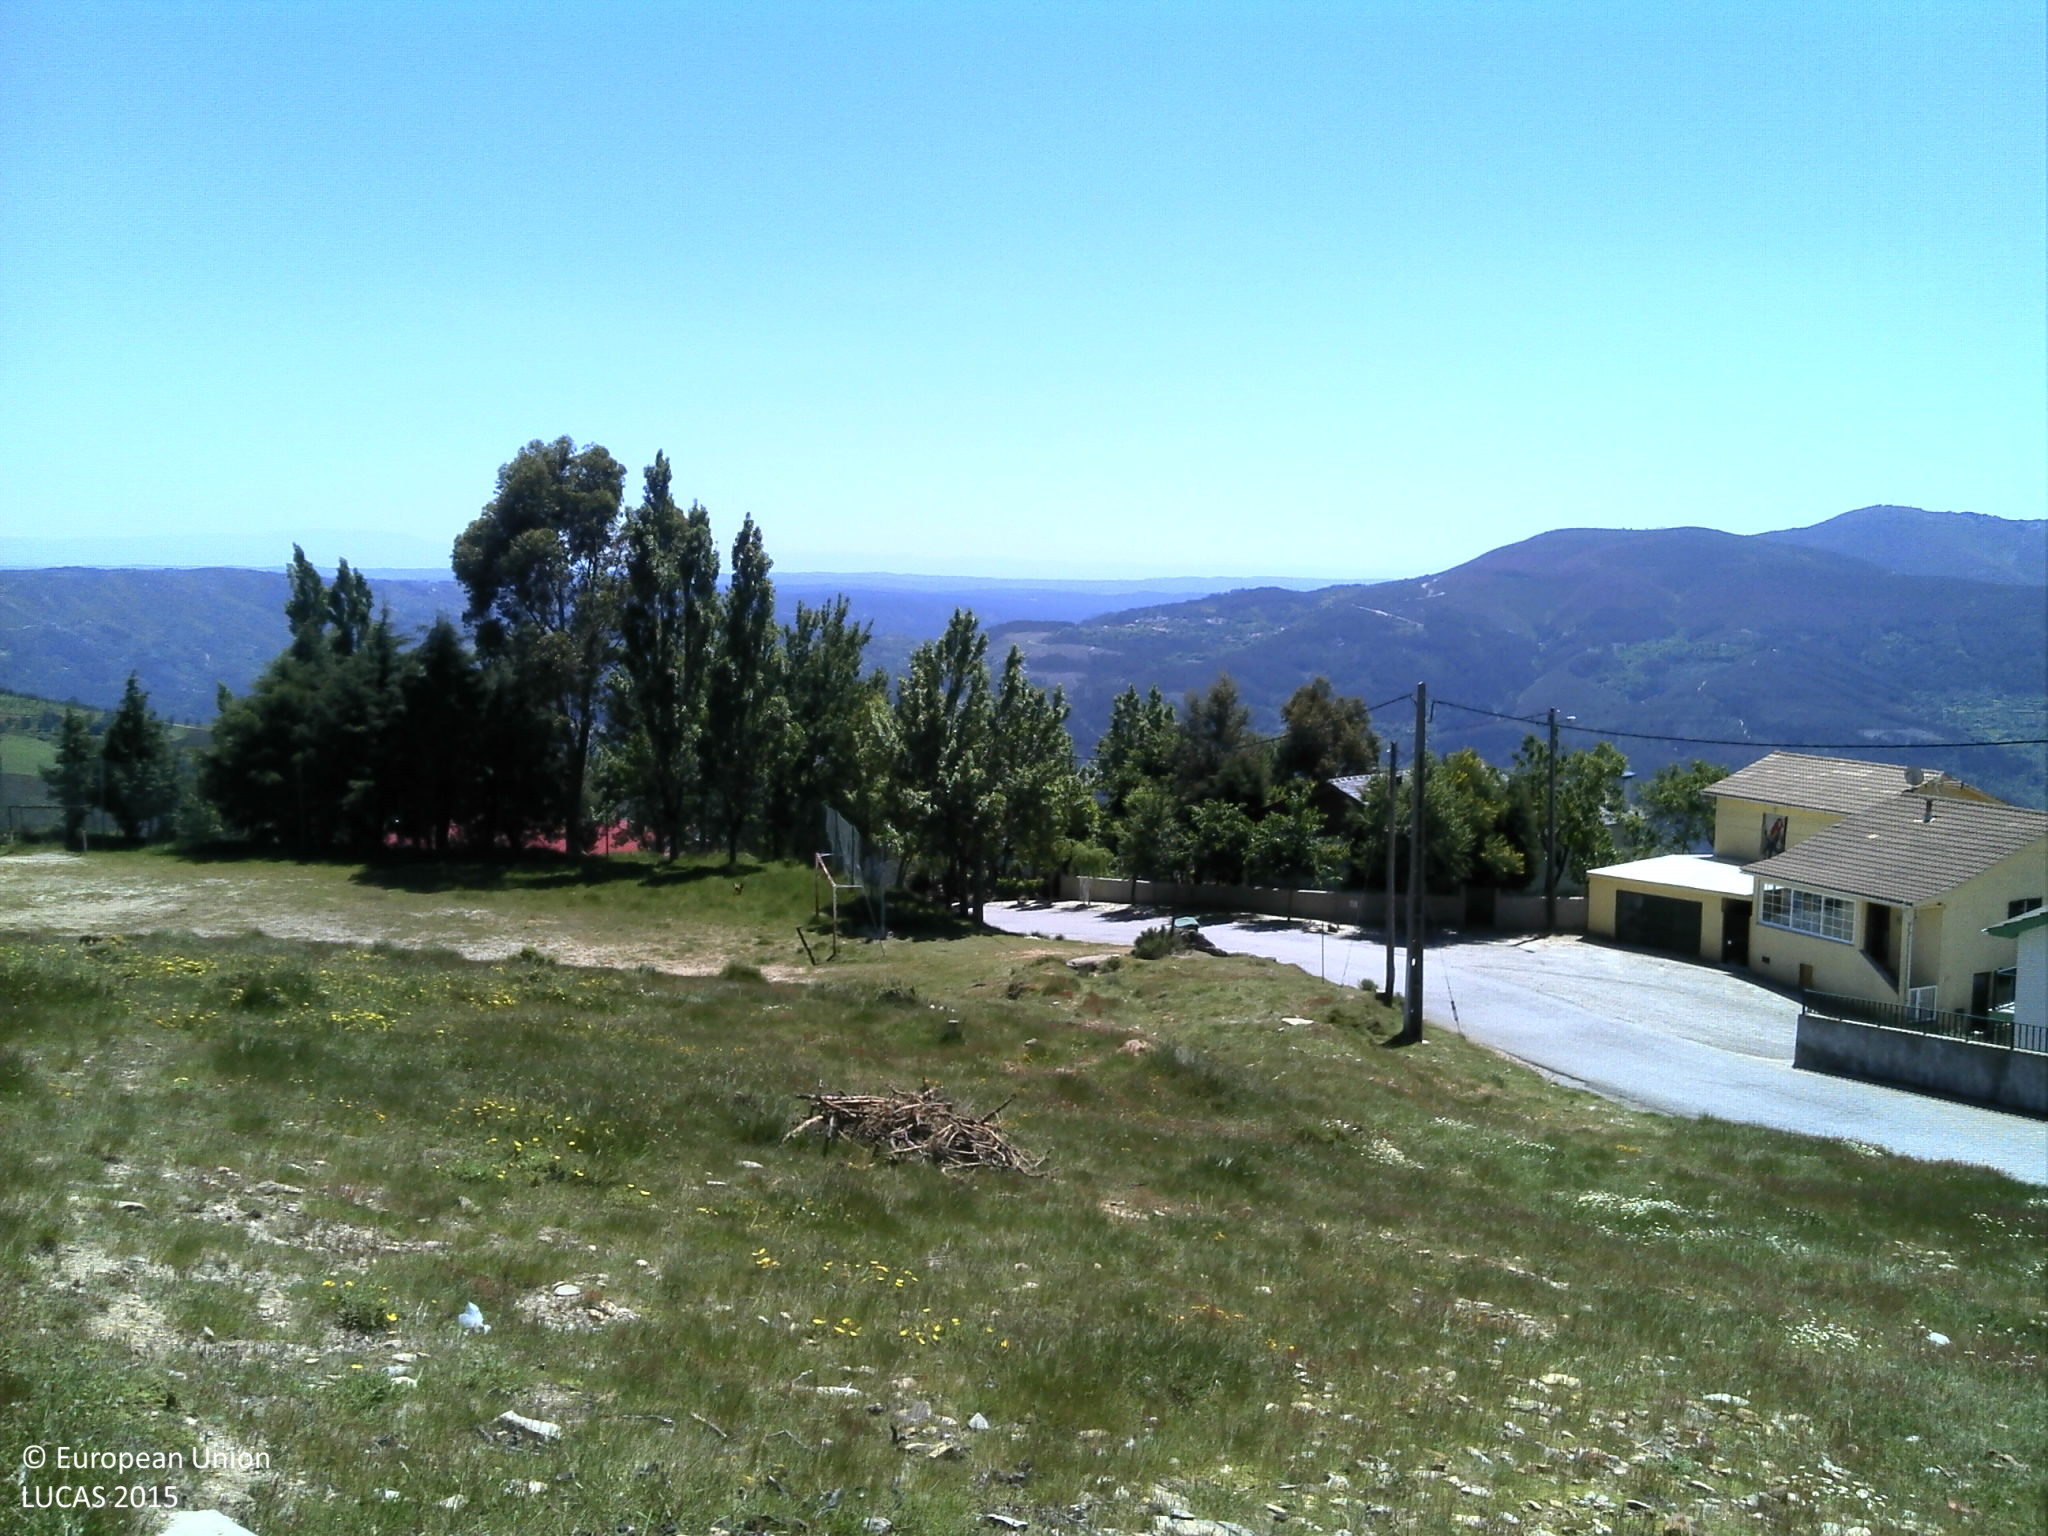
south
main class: Cropland
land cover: Other fresh vegetables
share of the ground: 50 - 75 %
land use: Kitchen garden
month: May
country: PT
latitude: 40.9455
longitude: -8.0338
